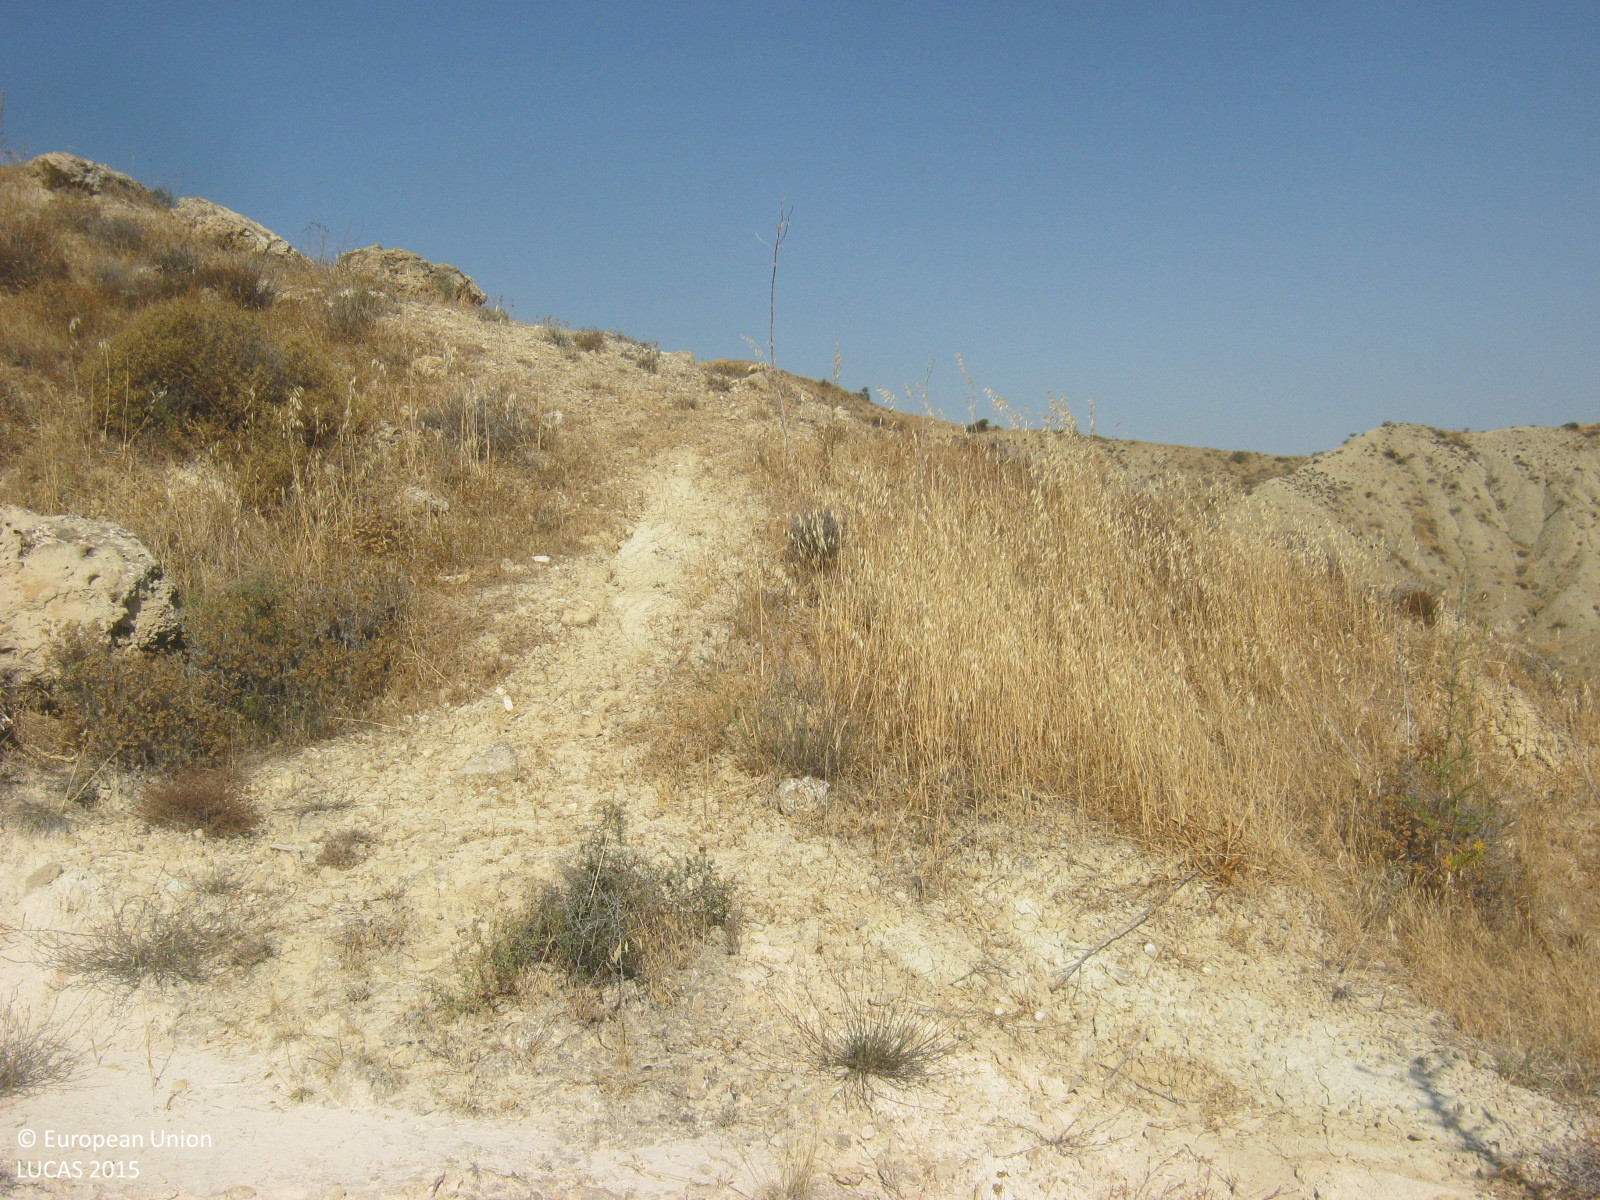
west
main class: Shrubland
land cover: Shrubland without tree cover
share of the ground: 10 - 25 %
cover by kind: unconsolidated bare surface 60 %, shrubs 20 %, herbaceous plants 20 %
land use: Semi-natural and natural areas not in use
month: June
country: CY
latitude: 35.0390
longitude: 33.2147
